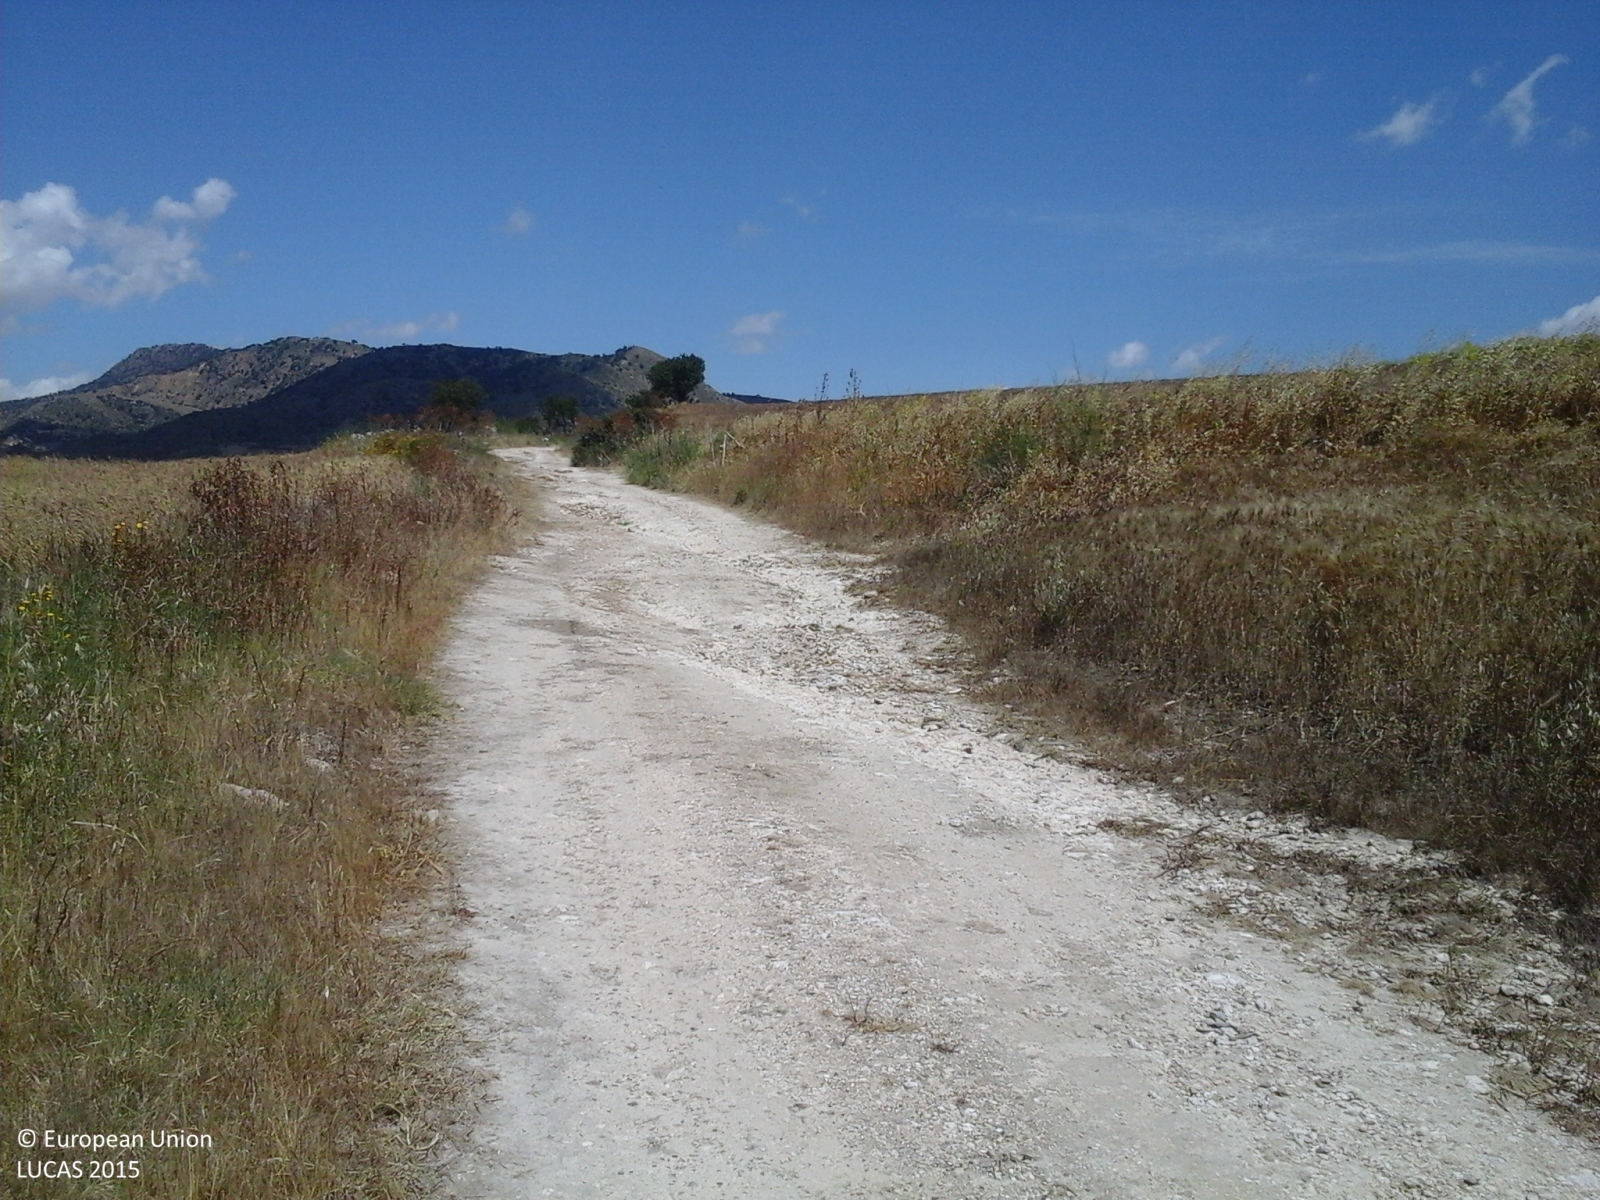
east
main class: Cropland
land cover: Durum wheat
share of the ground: > 75 %
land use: Agriculture (excluding fallow land and kitchen gardens)
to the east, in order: Durum wheat; Grass margins; Durum wheat
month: June
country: IT
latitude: 37.8438
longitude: 13.5765
